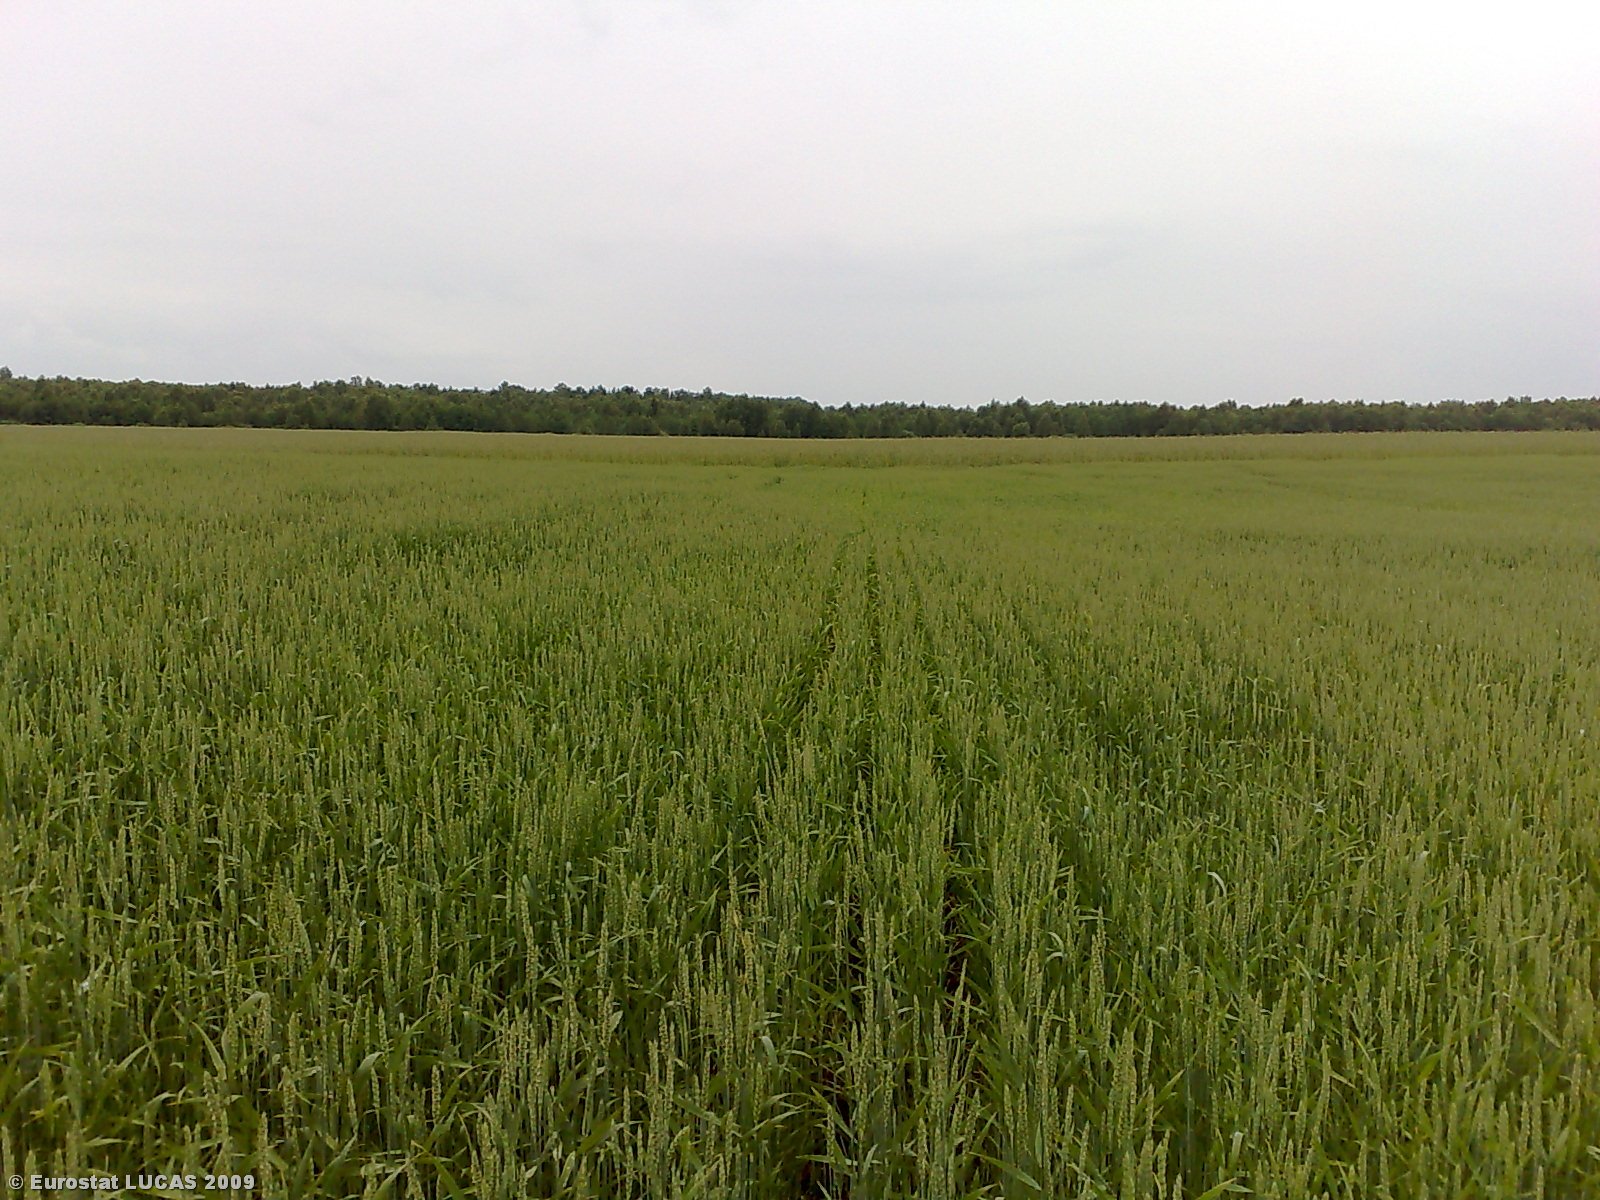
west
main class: Cropland
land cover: Common wheat
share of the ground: > 75 %
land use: Agriculture (excluding fallow land and kitchen gardens)
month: June
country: LT
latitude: 55.9380
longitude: 24.0648
